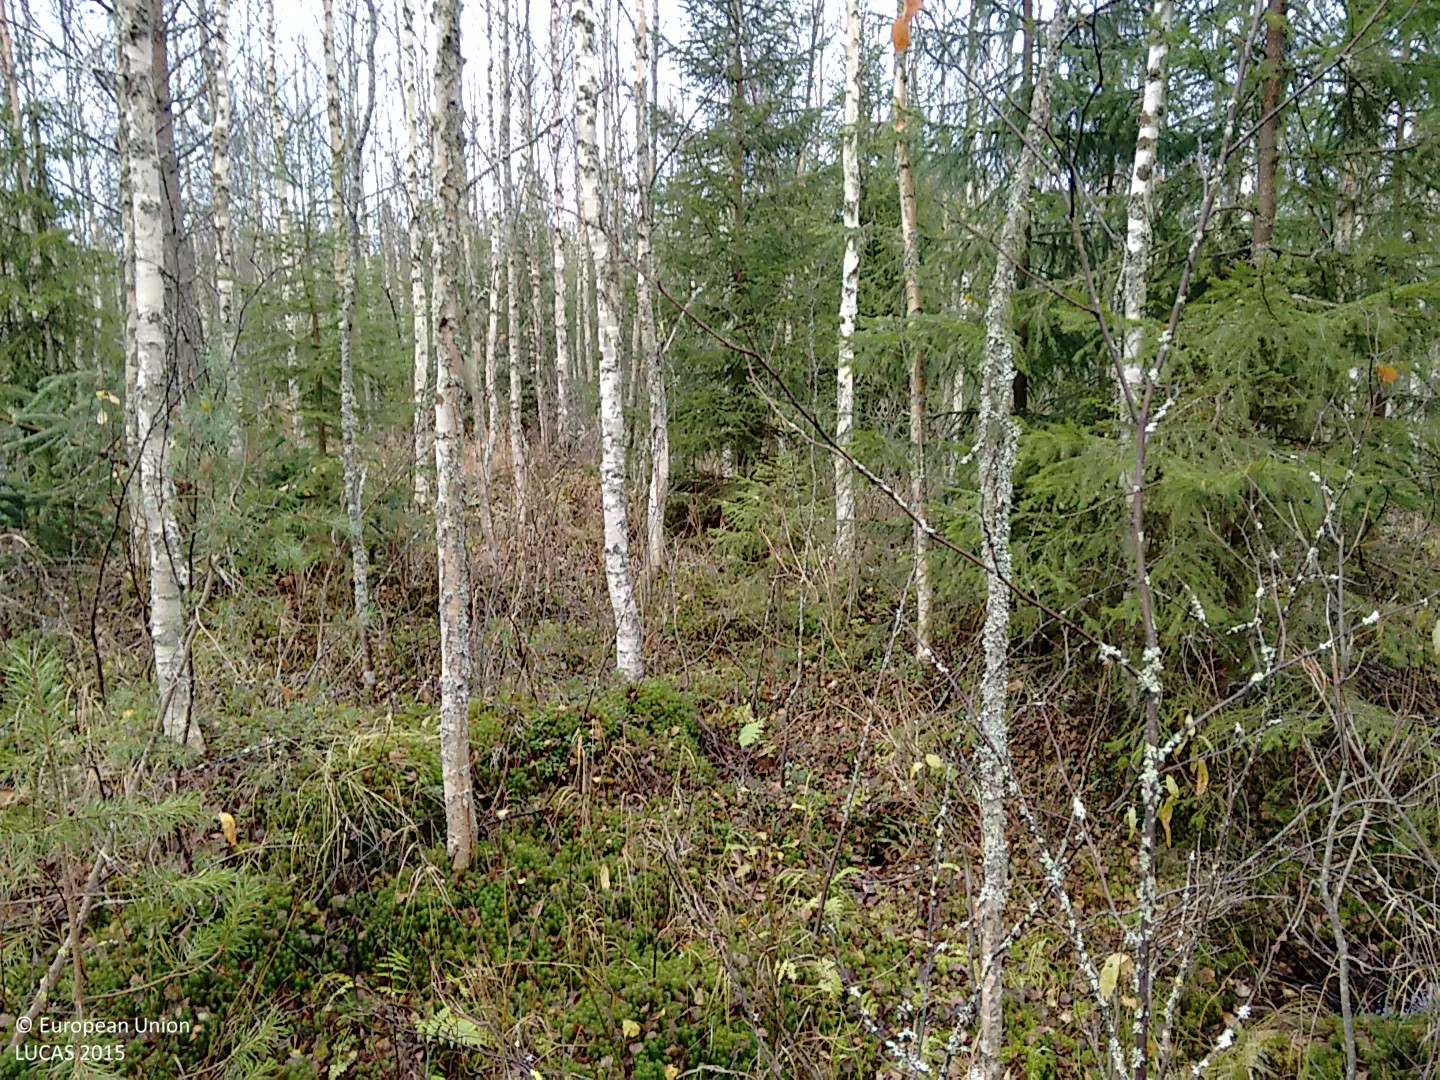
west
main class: Woodland
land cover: Spruce dominated mixed woodland
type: boreal forest
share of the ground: > 75 %
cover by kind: broadleaved forest trees 45 %, coniferous forest trees 35 %, shrubs 20 %
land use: Forestry
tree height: > 5 m
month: October
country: FI
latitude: 64.3587
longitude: 24.8449
